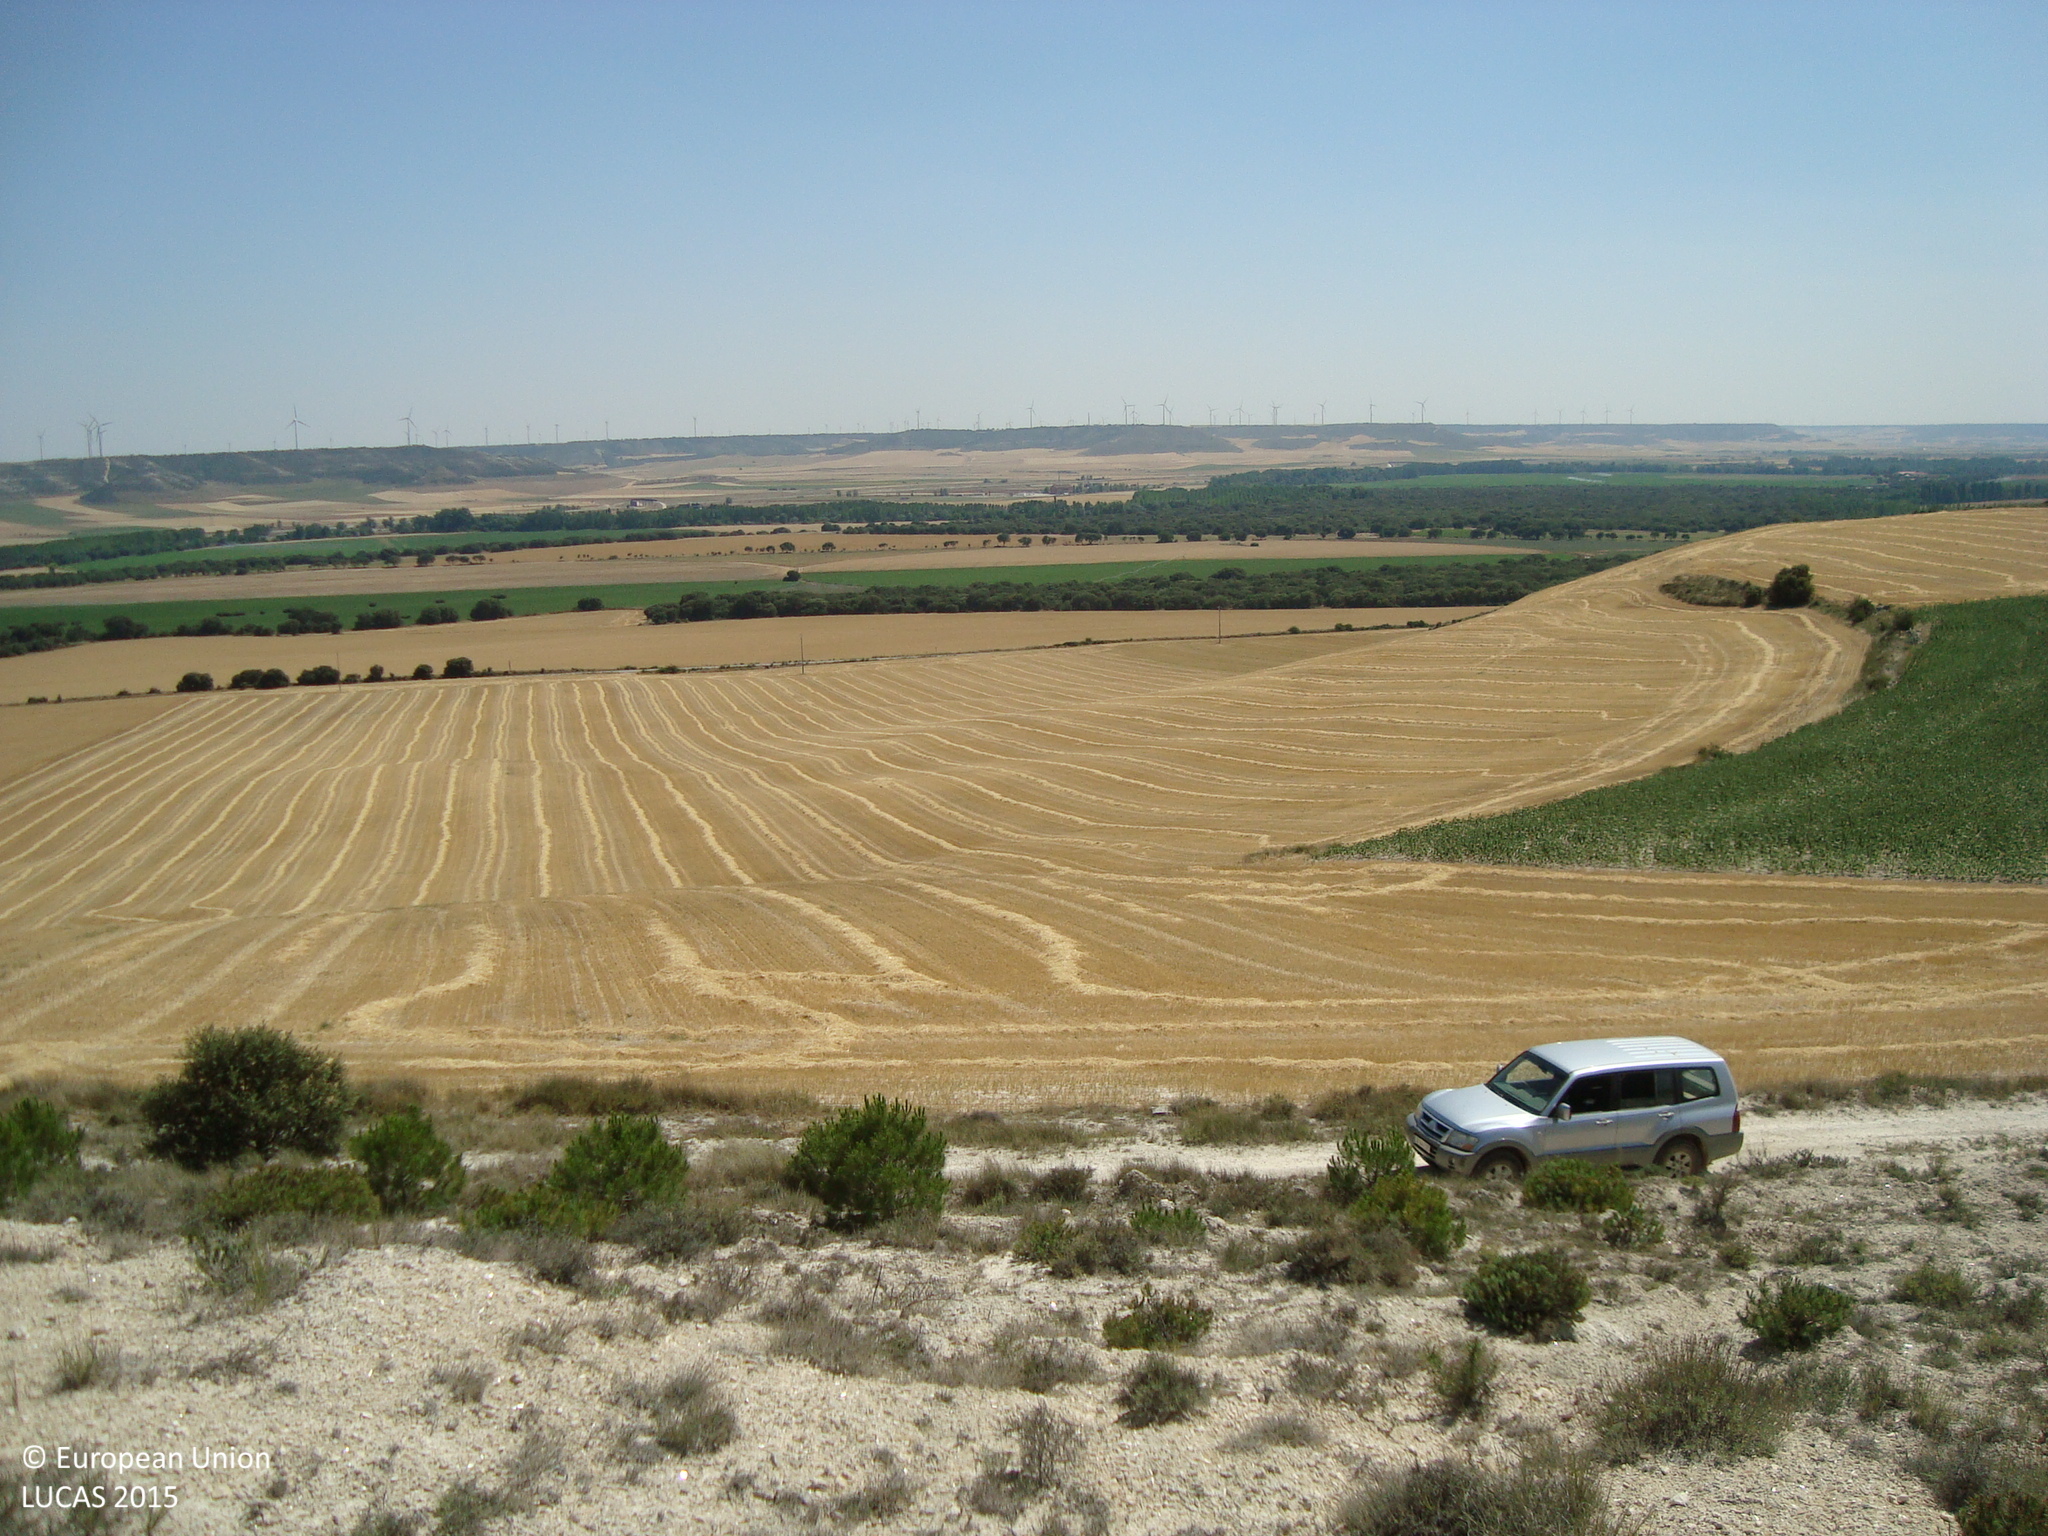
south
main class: Woodland
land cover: Pine dominated coniferous woodland
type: coniferous forest of the mediterranean region
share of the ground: 10 - 25 %
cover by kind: unconsolidated bare surface 75 %, coniferous forest trees 10 %, shrubs 10 %, herbaceous plants 5 %
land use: Forestry
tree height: < 5 m
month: July
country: ES
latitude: 42.0807
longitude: -4.2455
